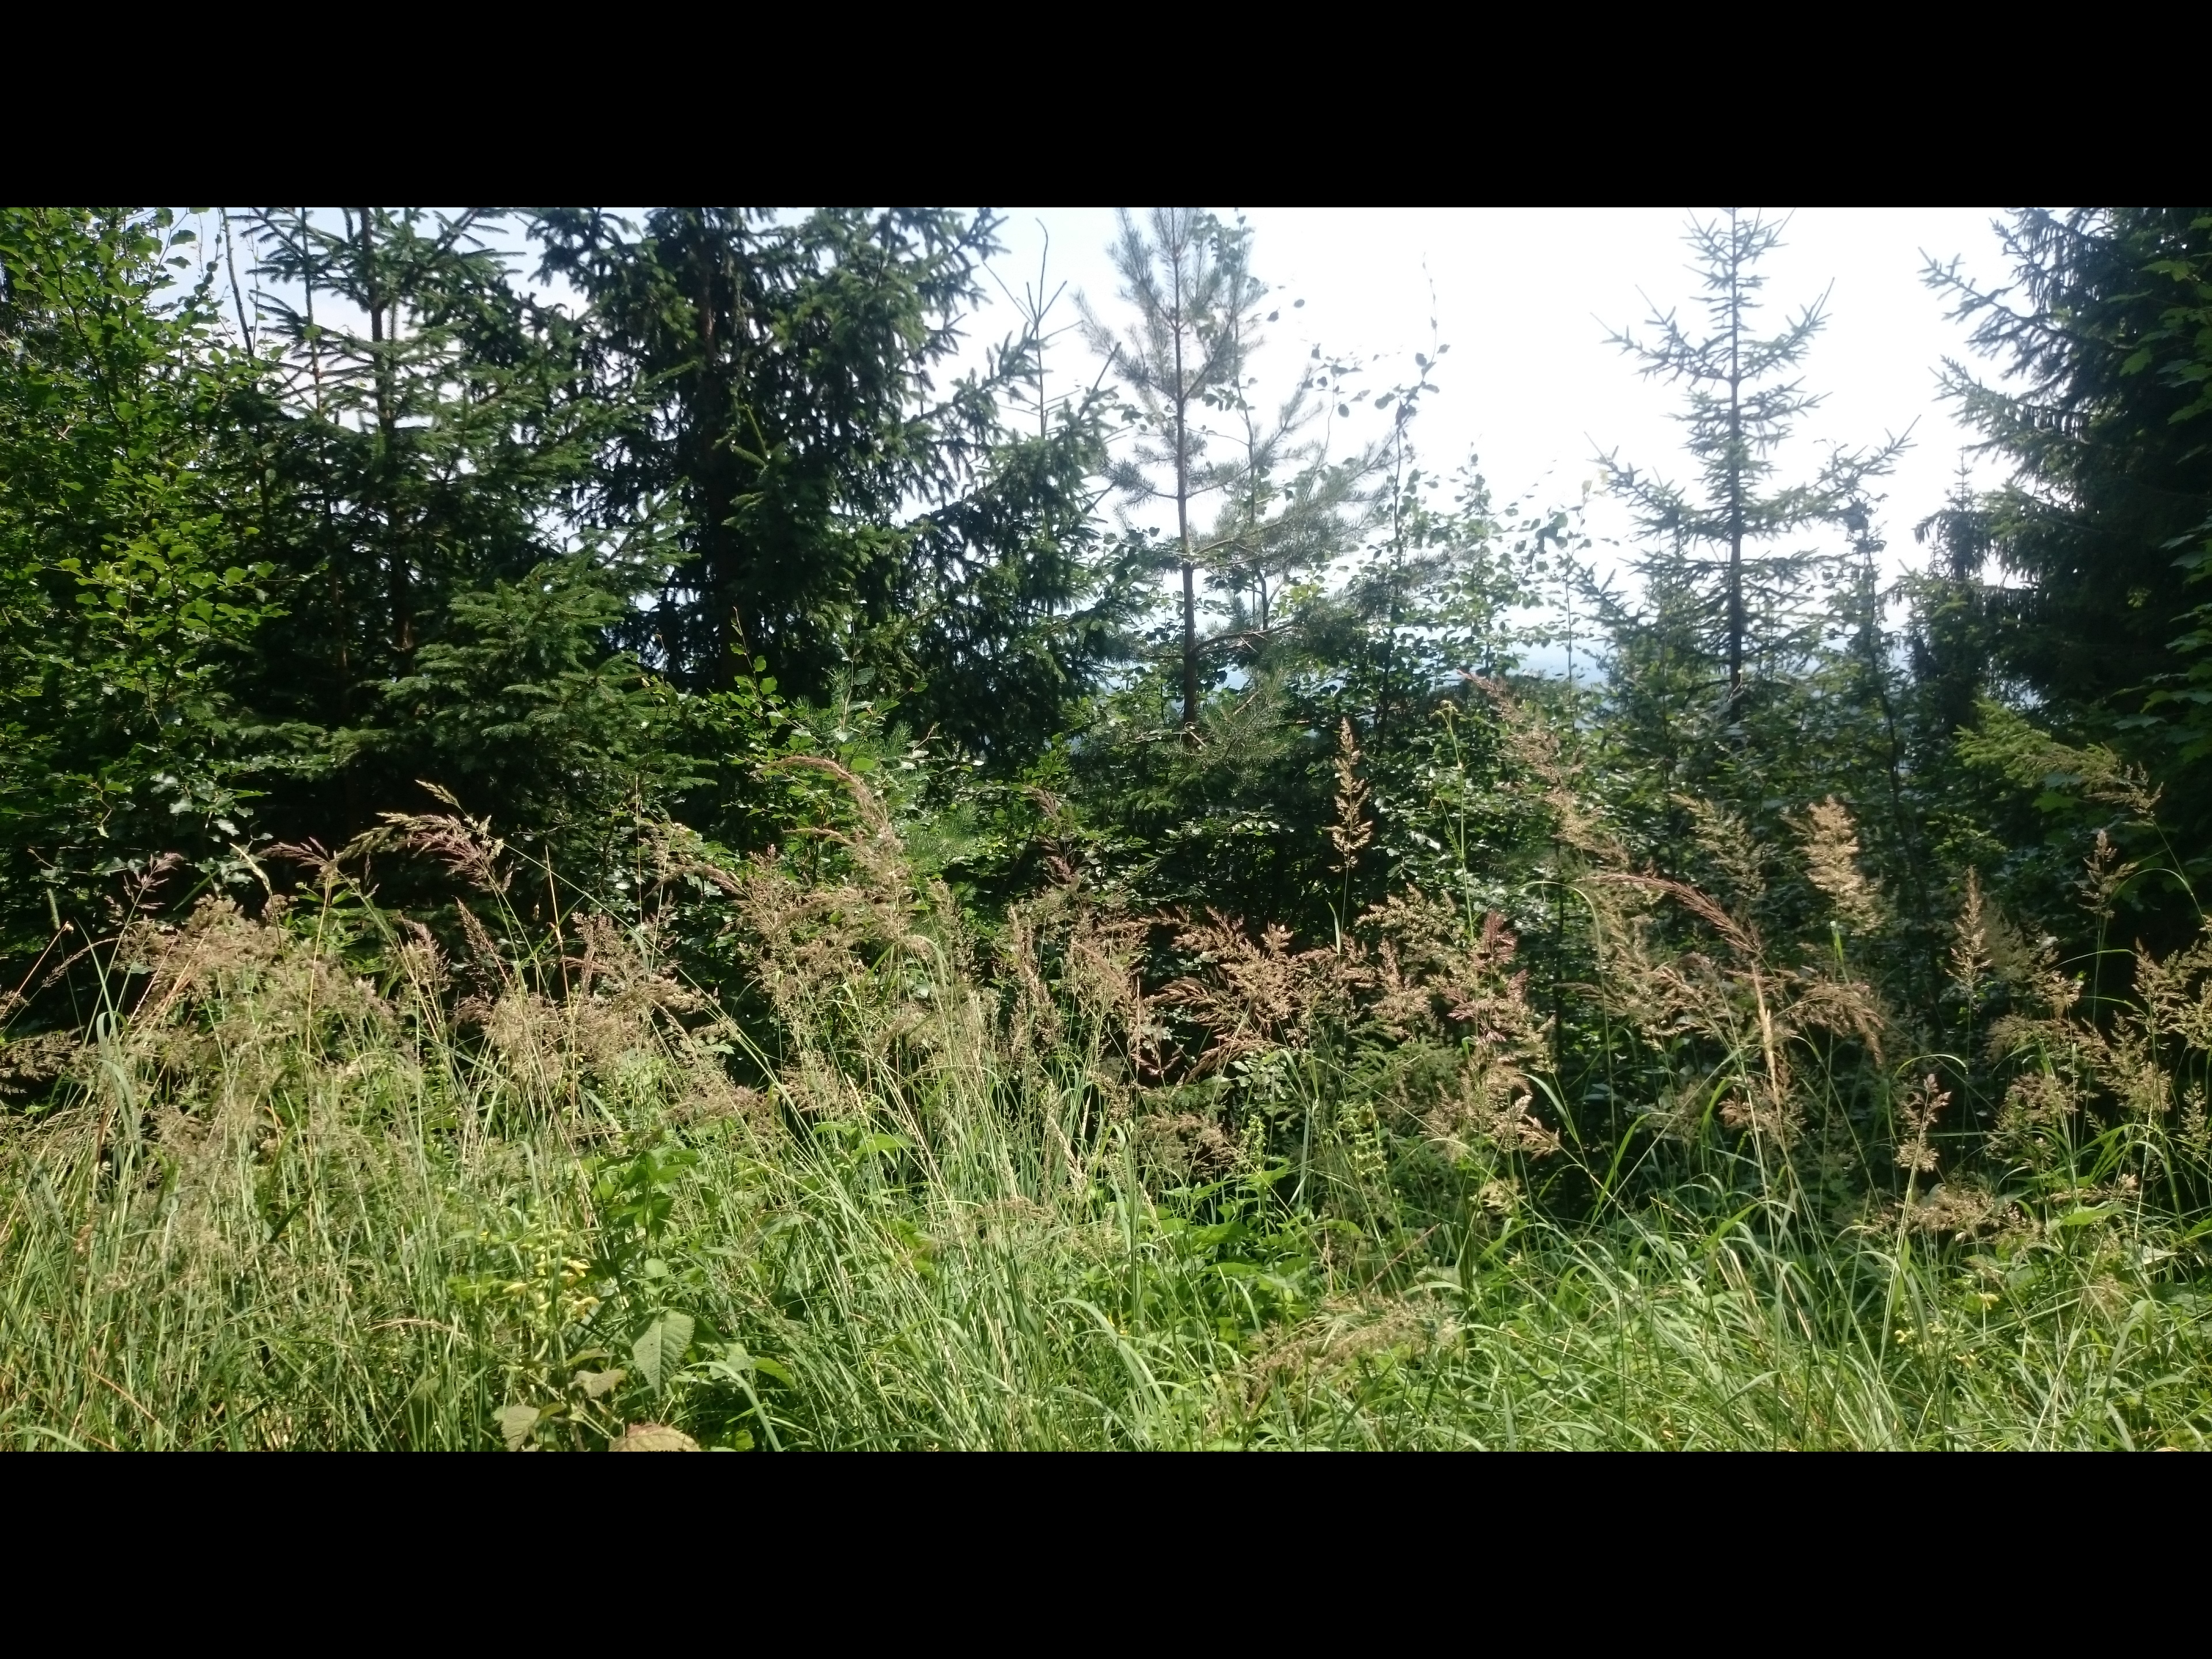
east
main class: Woodland
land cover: Spruce dominated mixed woodland
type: hemiboreal forest and nemoral coniferous forest and mixed broadleaved-coniferous forest
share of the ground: > 75 %
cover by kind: coniferous forest trees 65 %, broadleaved forest trees 25 %, herbaceous plants 10 %
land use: Forestry
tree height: > 5 m
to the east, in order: Spruce dominated mixed woodland; Tracks; Spruce dominated mixed woodland; Artificial constructions in urban areas; Grassland without tree/shrub cover; Fences; Spruce dominated coniferous woodland; Broadleaved woodland; Grassland without tree/shrub cover
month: July
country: AT
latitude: 47.1855
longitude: 15.4769
